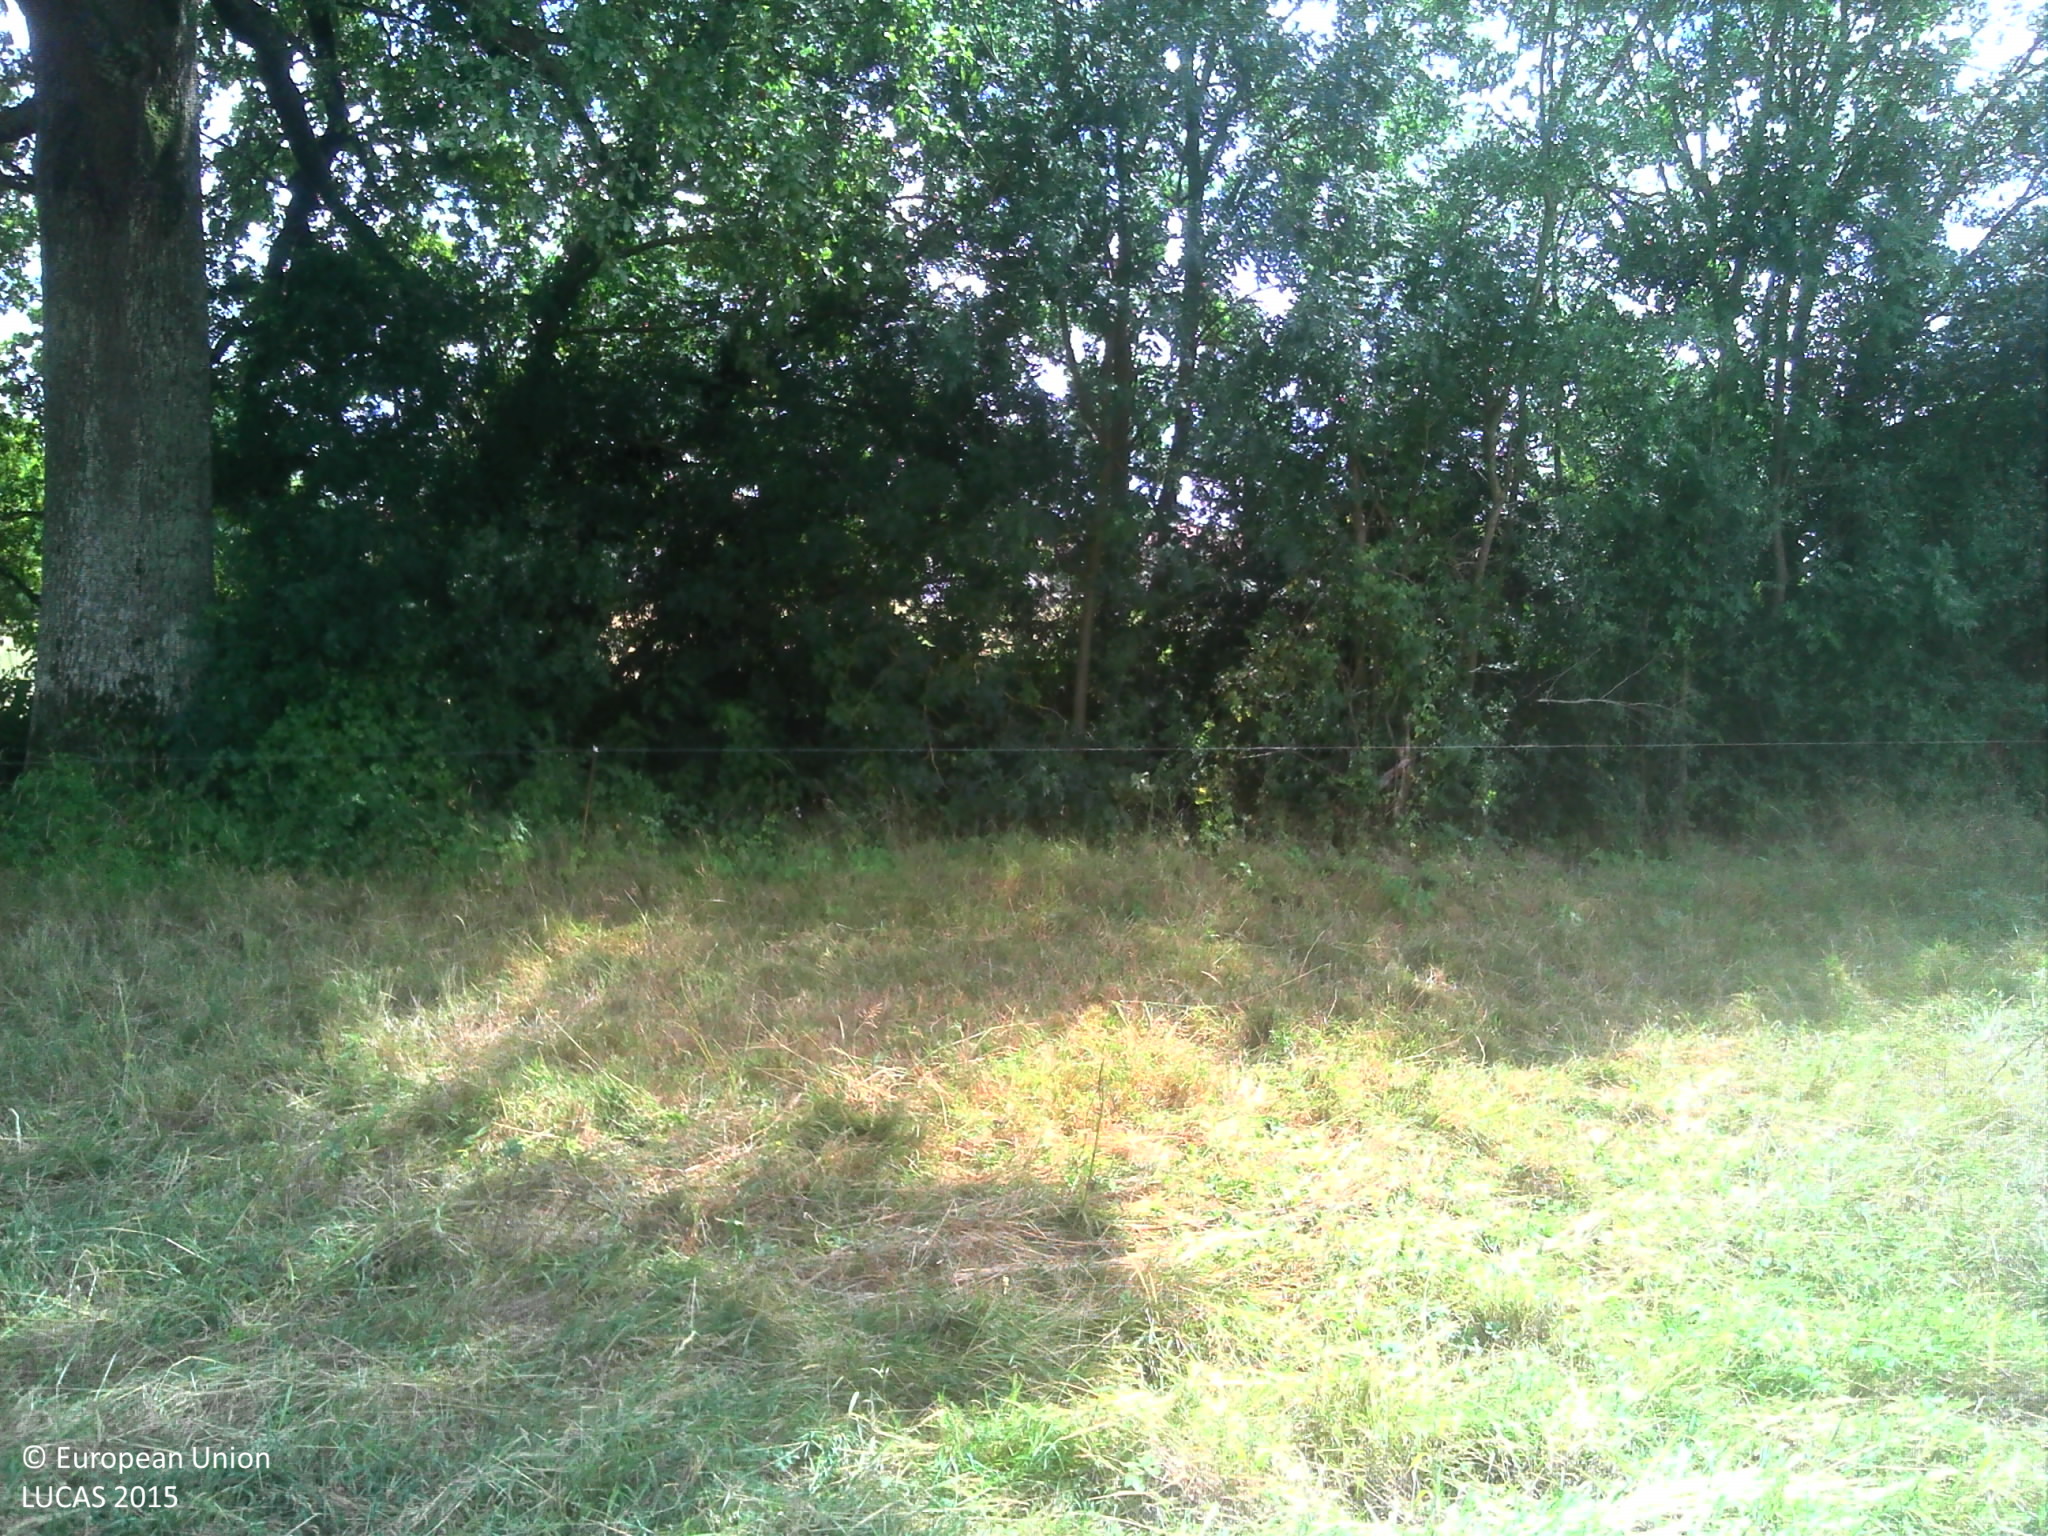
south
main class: Grassland
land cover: Grassland without tree/shrub cover
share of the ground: > 75 %
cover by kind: herbaceous plants 100 %
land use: Agriculture (excluding fallow land and kitchen gardens)
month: July
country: FR
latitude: 46.4923
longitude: -1.3313
